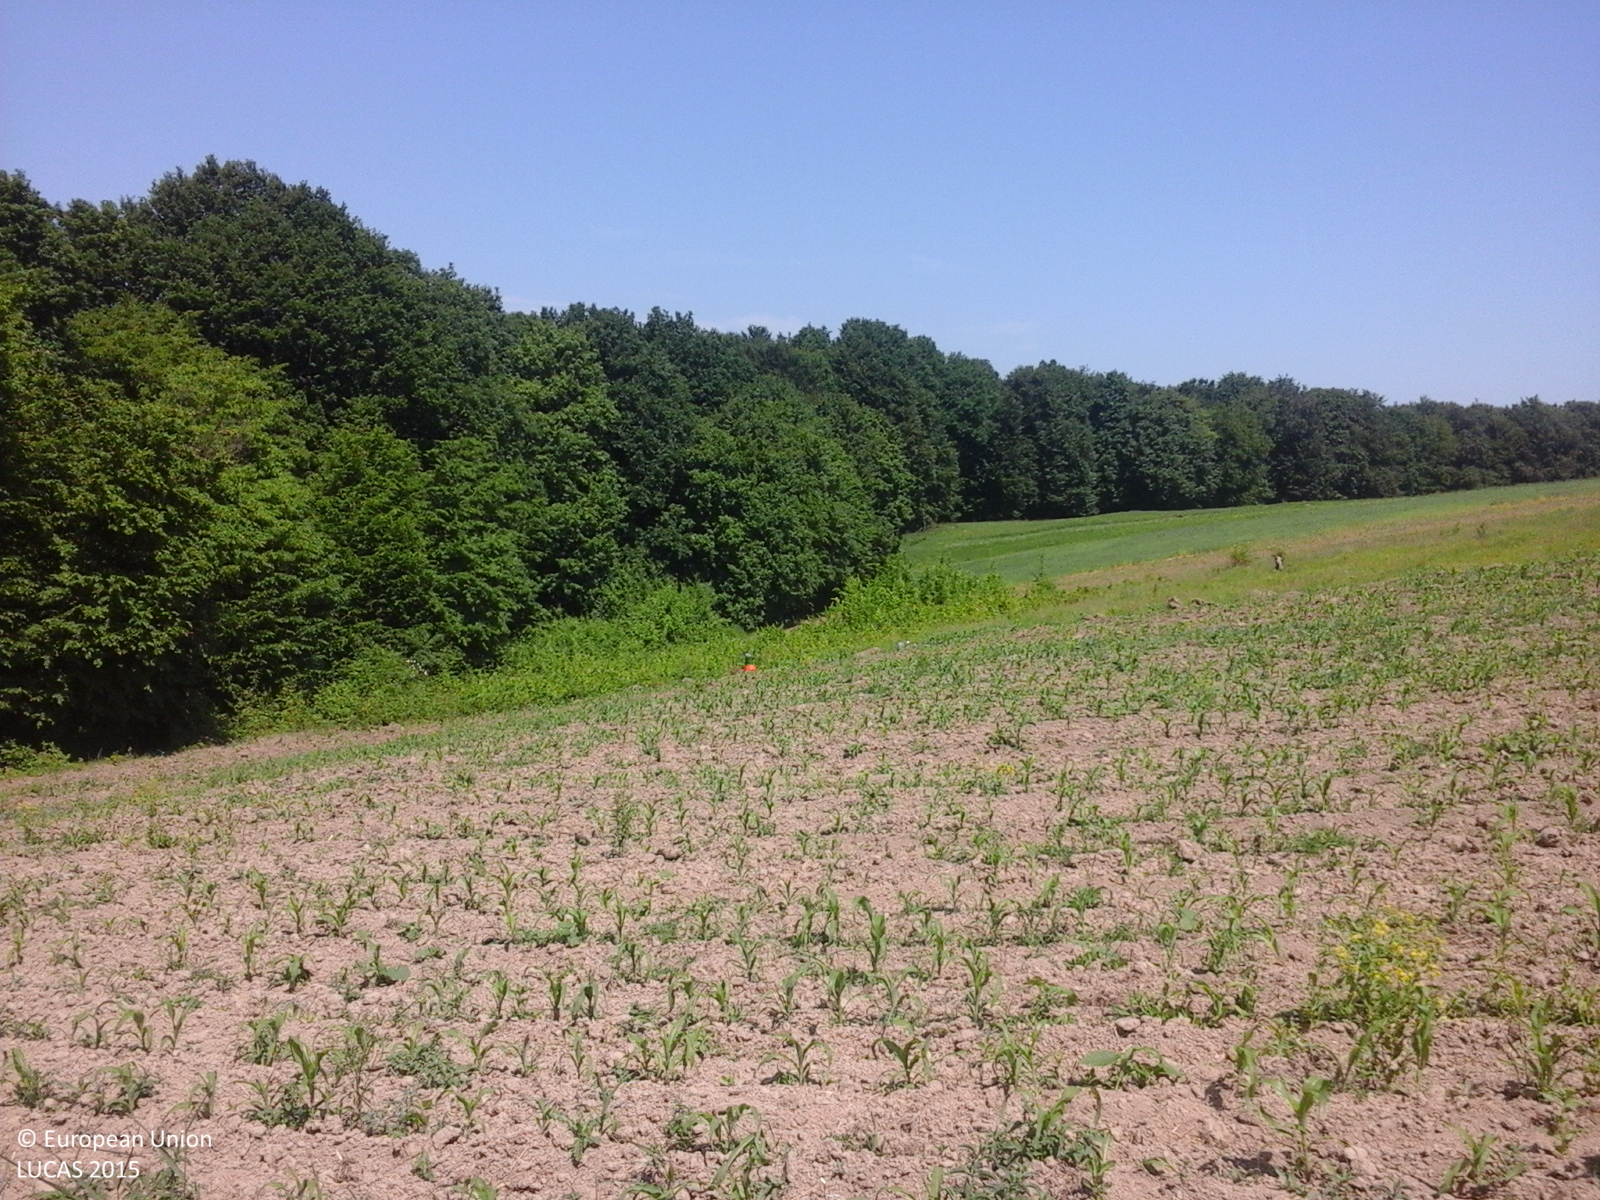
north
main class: Cropland
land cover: Common wheat
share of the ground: 50 - 75 %
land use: Agriculture (excluding fallow land and kitchen gardens)
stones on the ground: < 10 %
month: June
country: RO
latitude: 46.3377
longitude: 26.8898
